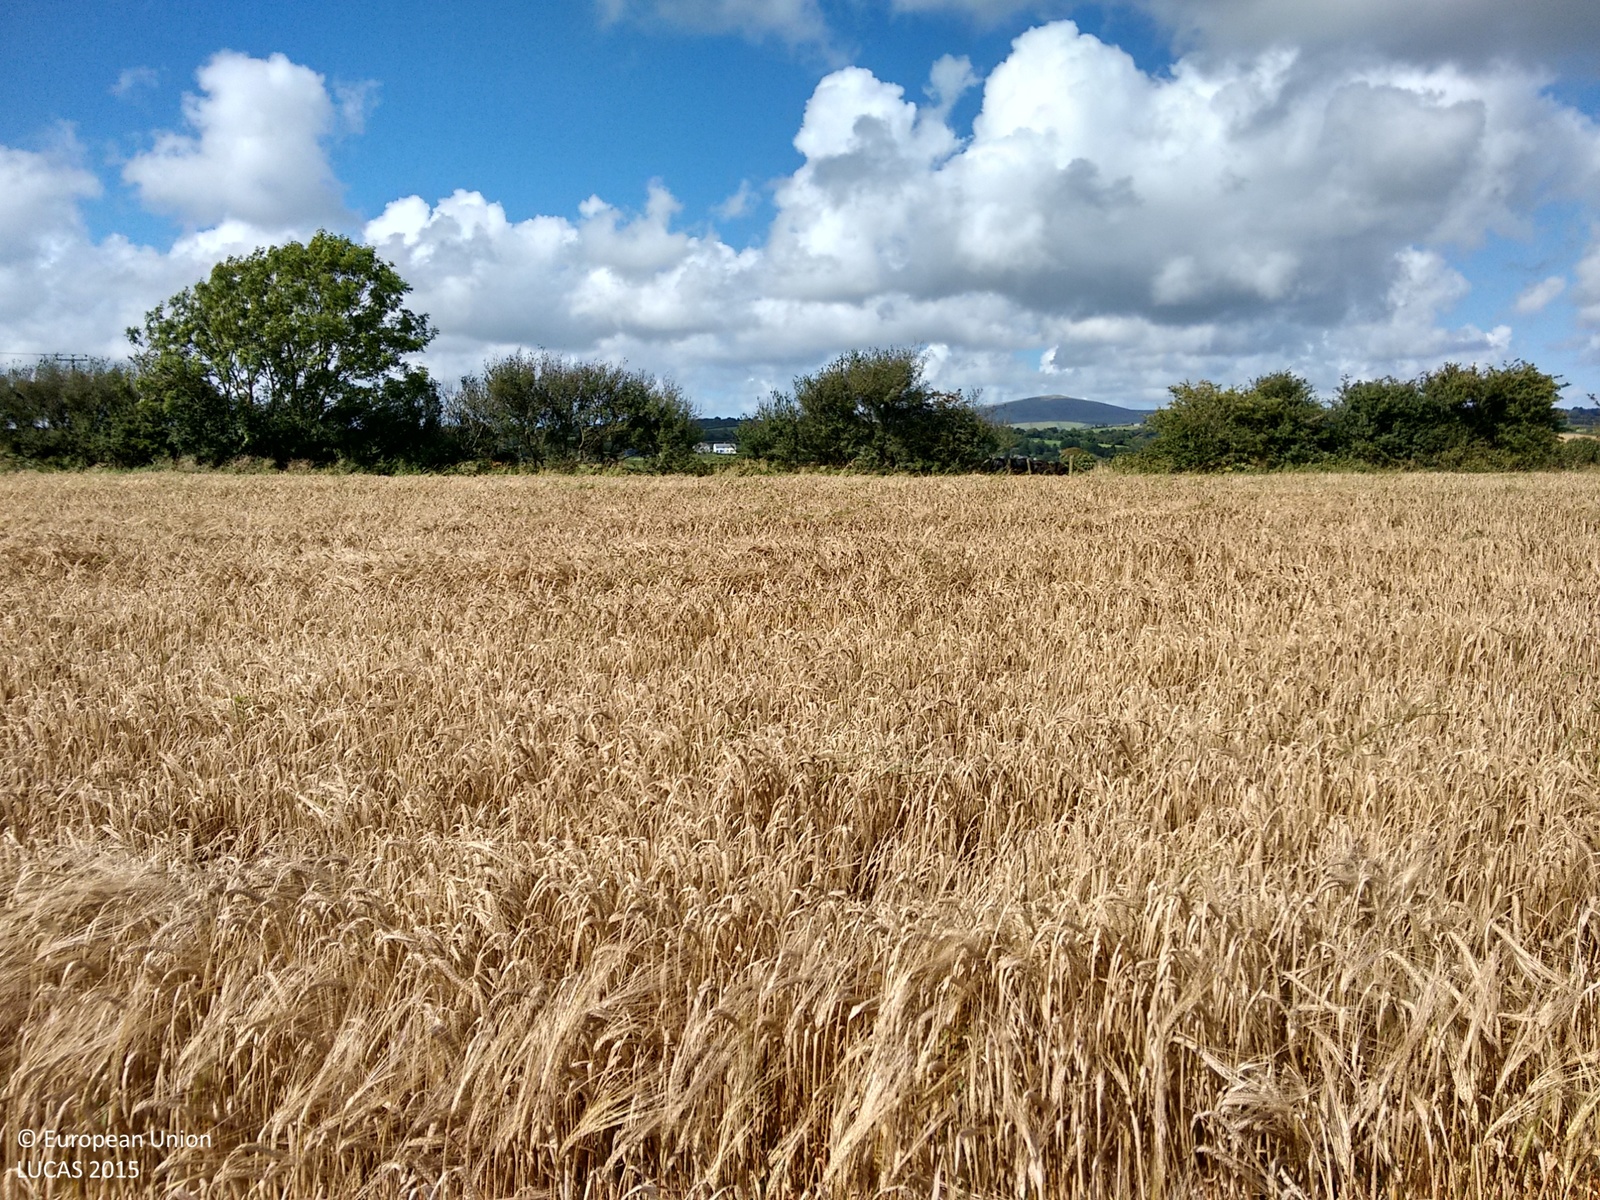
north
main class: Cropland
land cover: Barley
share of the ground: > 75 %
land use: Agriculture (excluding fallow land and kitchen gardens)
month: August
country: GB
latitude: 51.8678
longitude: -4.7652
